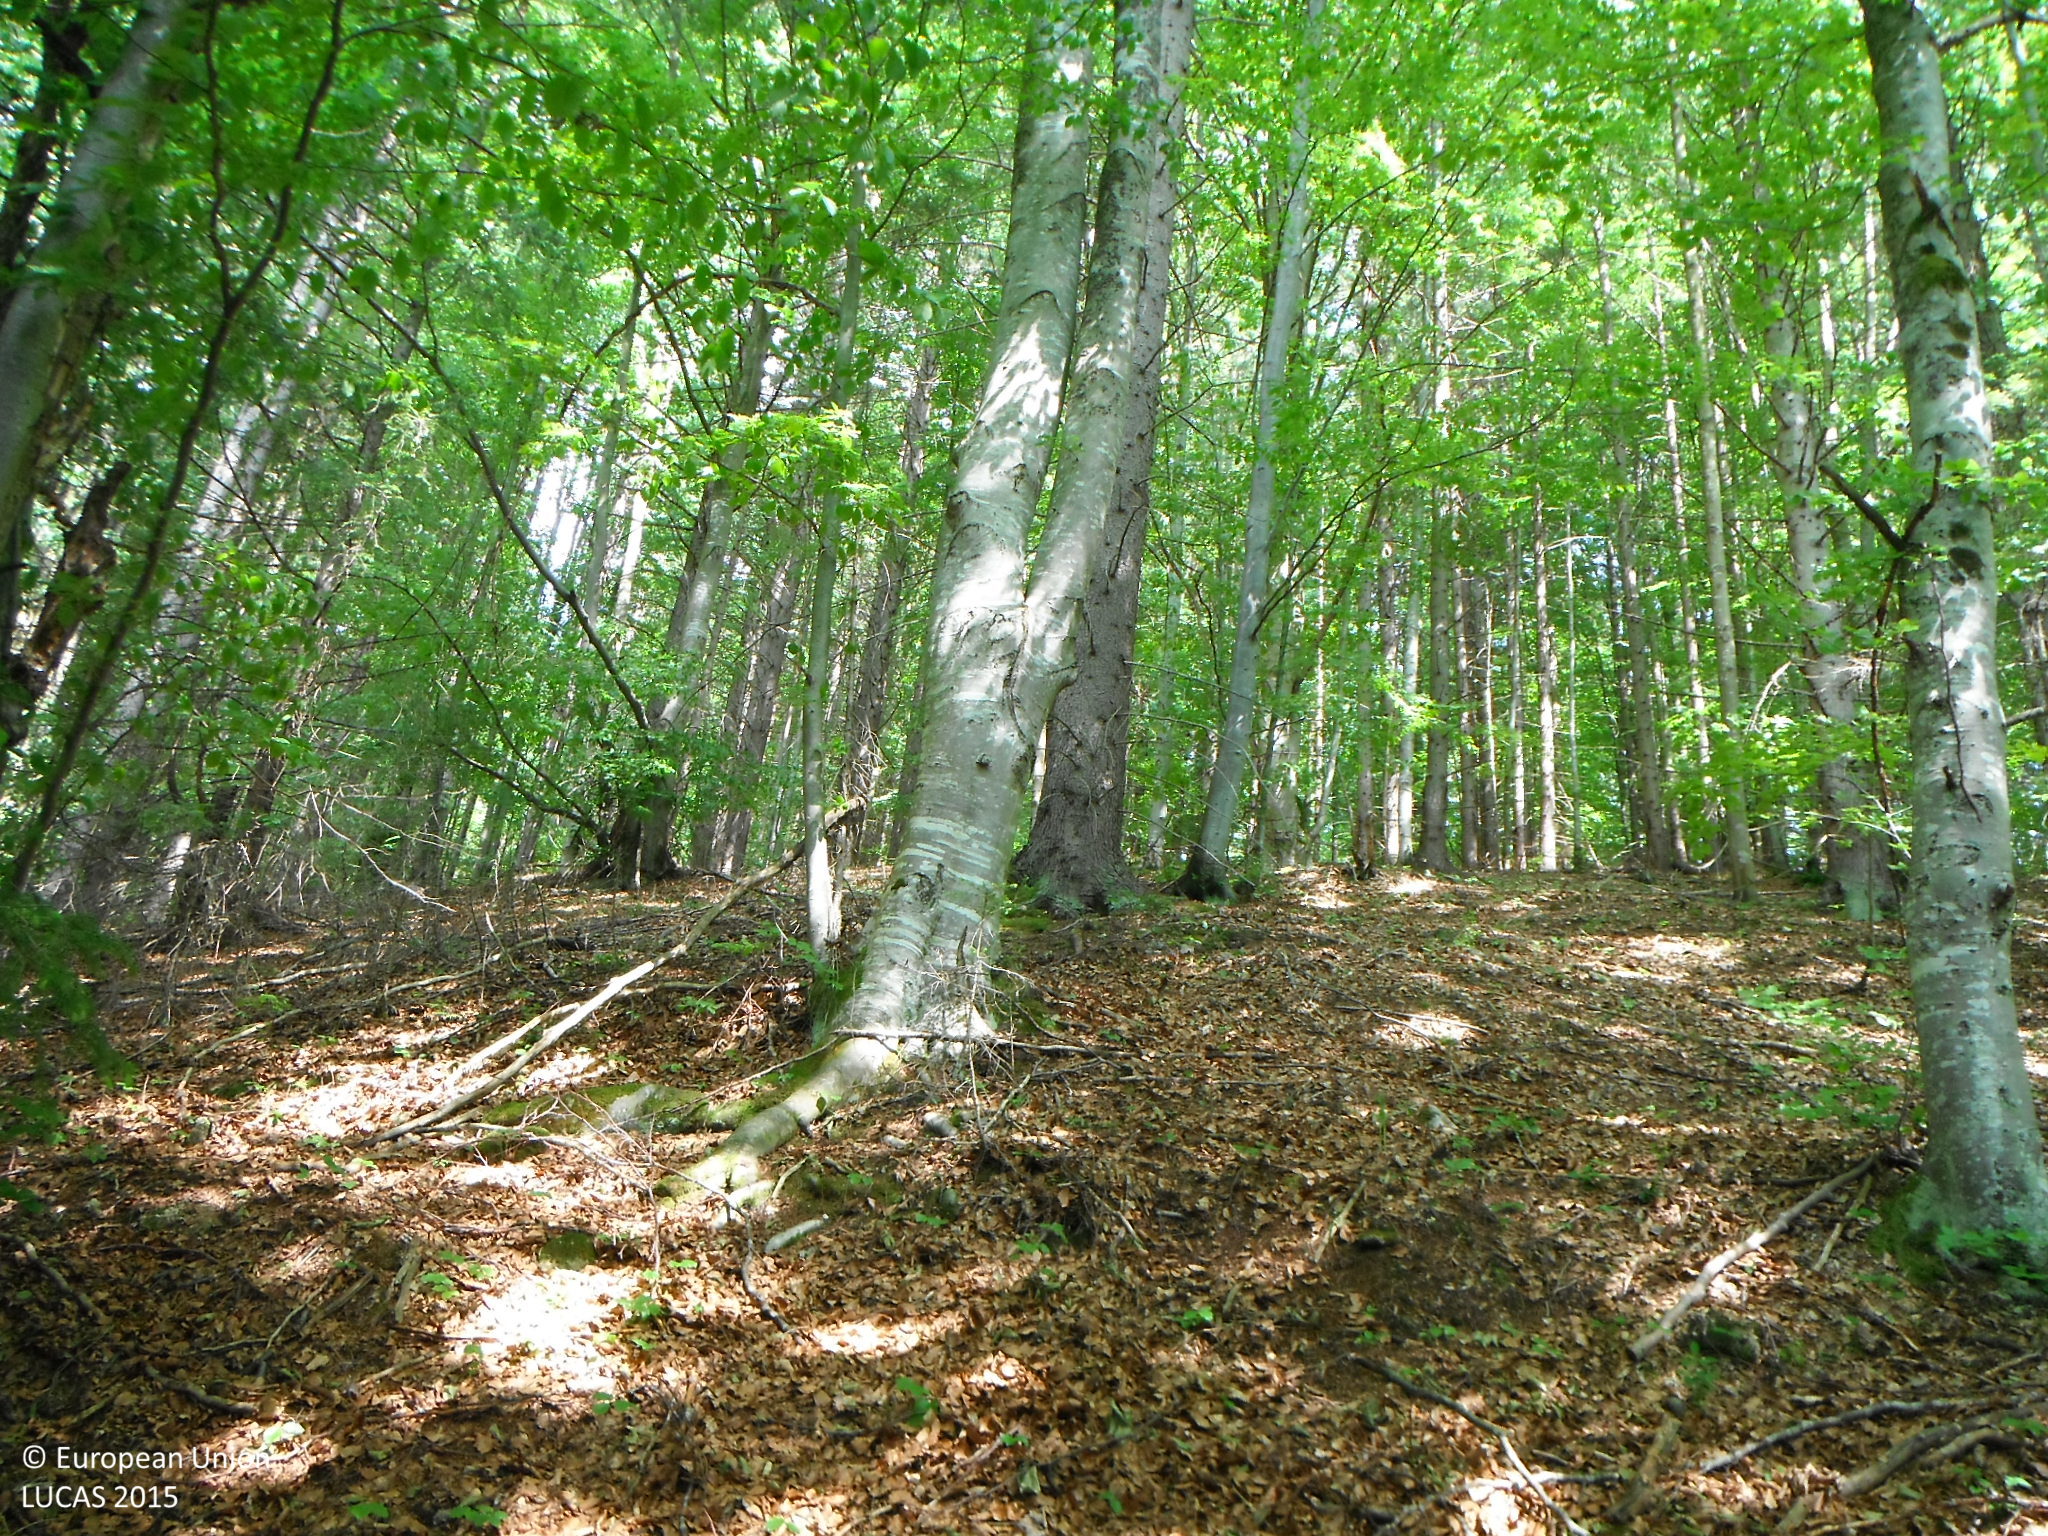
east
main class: Woodland
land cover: Spruce dominated mixed woodland
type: mountainous beech forest
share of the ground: > 75 %
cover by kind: broadleaved forest trees 75 %, coniferous forest trees 25 %
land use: Forestry
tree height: > 5 m
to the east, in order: Spruce dominated mixed woodland; Spruce dominated coniferous woodland; Spruce dominated mixed woodland; Shrubland without tree cover; Spontaneously vegetated surfaces; Managed hedges; Spruce dominated coniferous woodland; Grassland without tree/shrub cover; Single bushes/trees; Grassland without tree/shrub cover; Tracks; Single bushes/trees; Grassland without tree/shrub cover
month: June
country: SK
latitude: 48.8492
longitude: 19.6619
